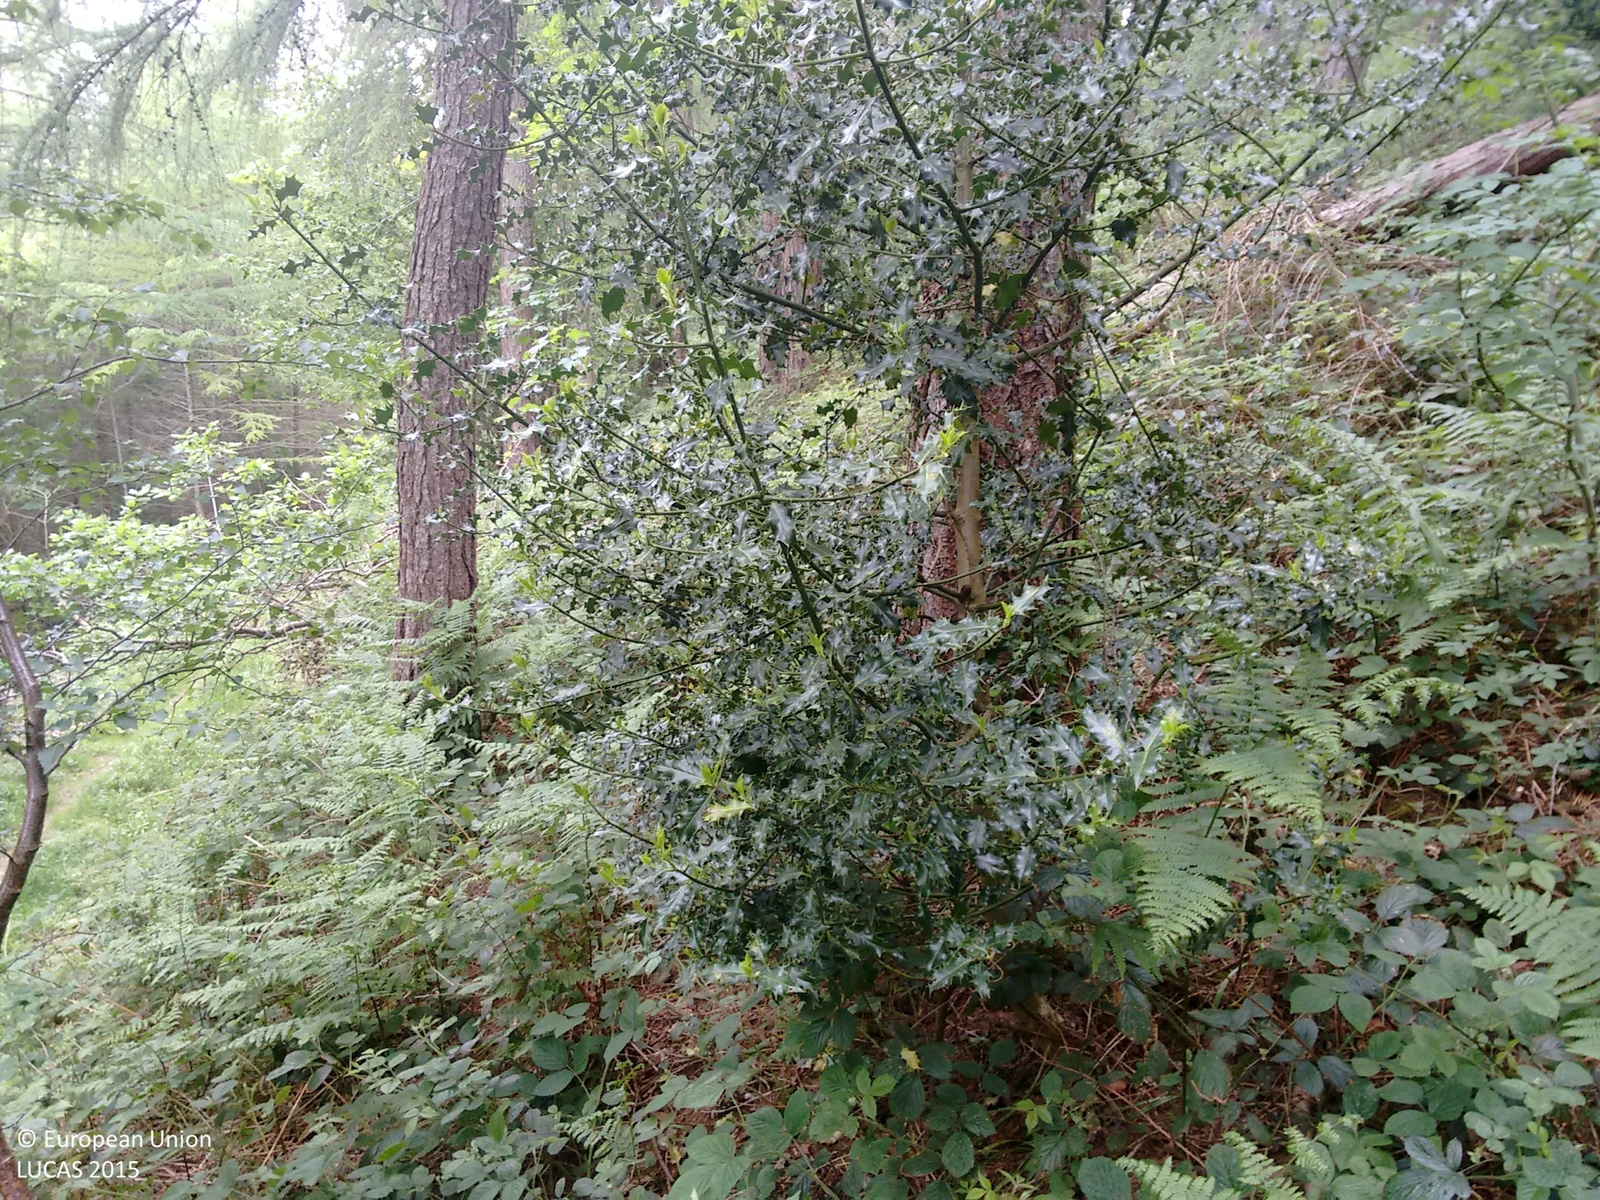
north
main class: Woodland
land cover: Pine dominated mixed woodland
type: exotic forest
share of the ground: > 75 %
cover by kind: coniferous forest trees 70 %, broadleaved forest trees 30 %
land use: Forestry
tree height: > 5 m
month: June
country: GB
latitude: 54.2712
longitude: -1.0840
